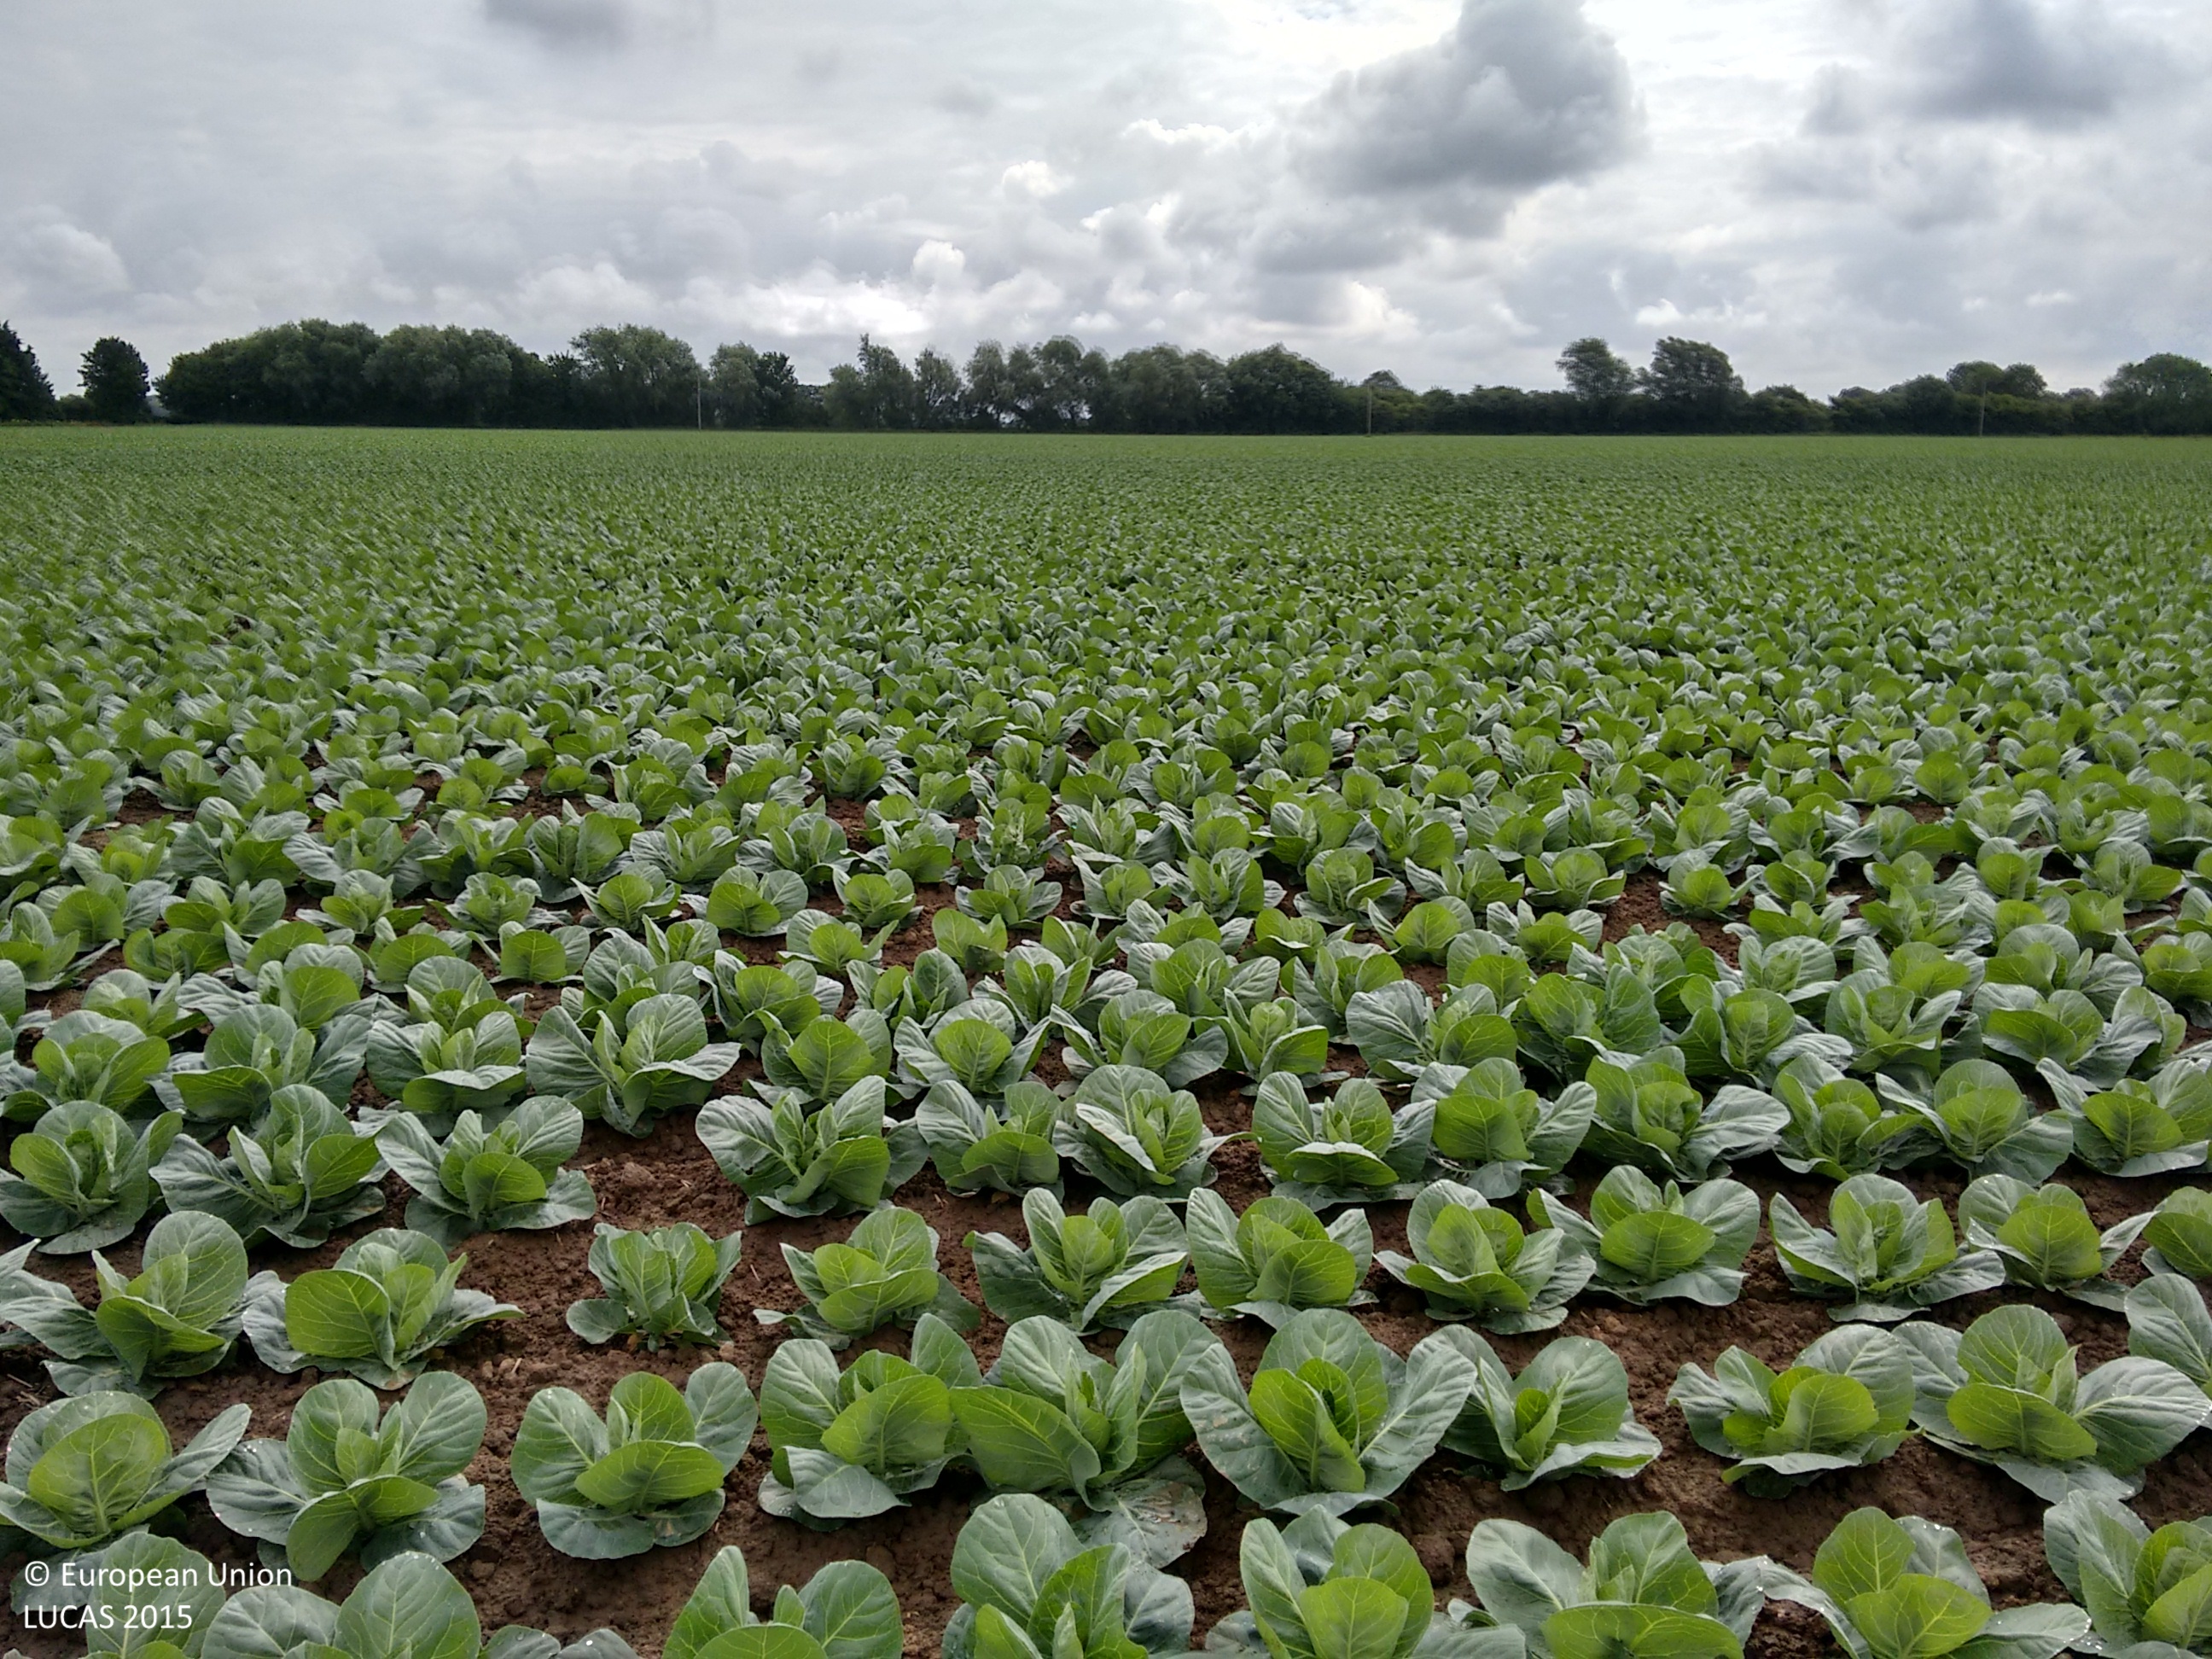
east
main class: Cropland
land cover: Other fresh vegetables
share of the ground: 50 - 75 %
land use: Agriculture (excluding fallow land and kitchen gardens)
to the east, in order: Other fresh vegetables
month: July
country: GB
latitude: 52.9975
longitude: -0.0905
